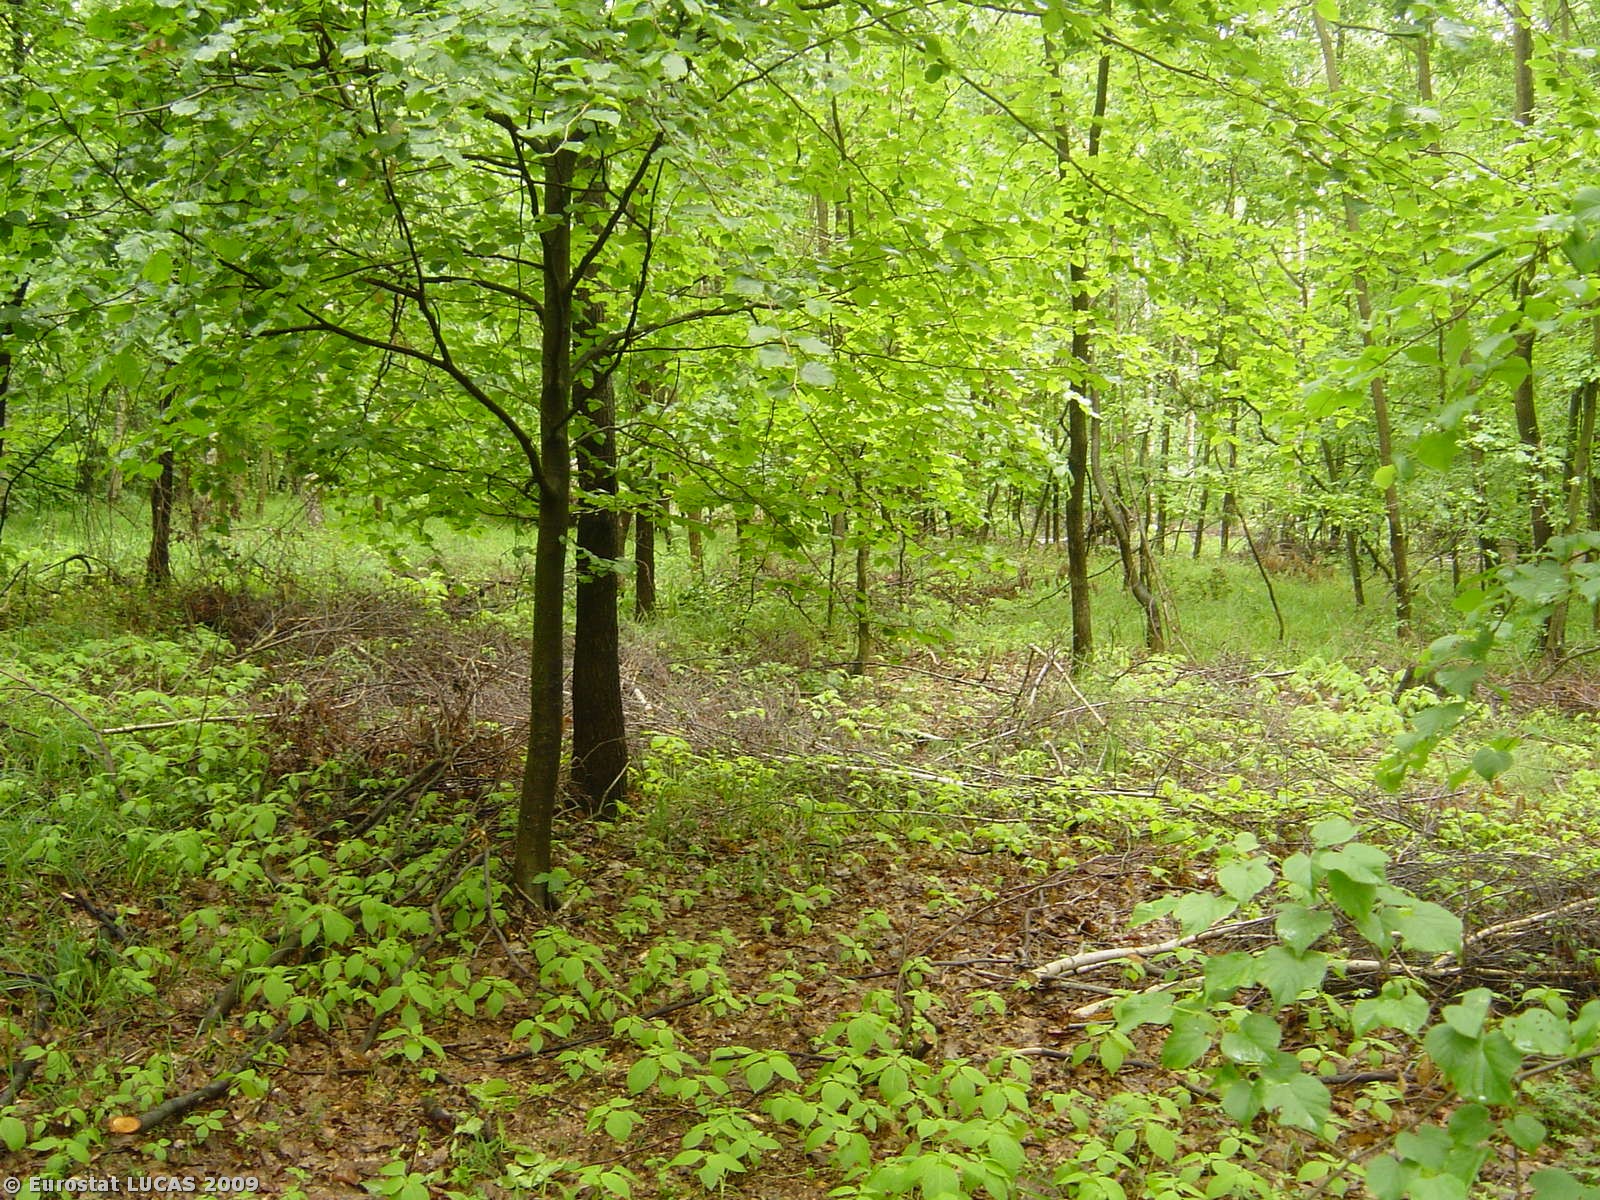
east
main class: Woodland
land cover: Broadleaved woodland
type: mesophytic deciduous forest
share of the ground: > 75 %
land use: Forestry
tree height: > 5 m
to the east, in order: Broadleaved woodland; Tracks; Broadleaved woodland; Tracks; Broadleaved woodland
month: May
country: CZ
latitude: 49.2238
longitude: 17.0808
